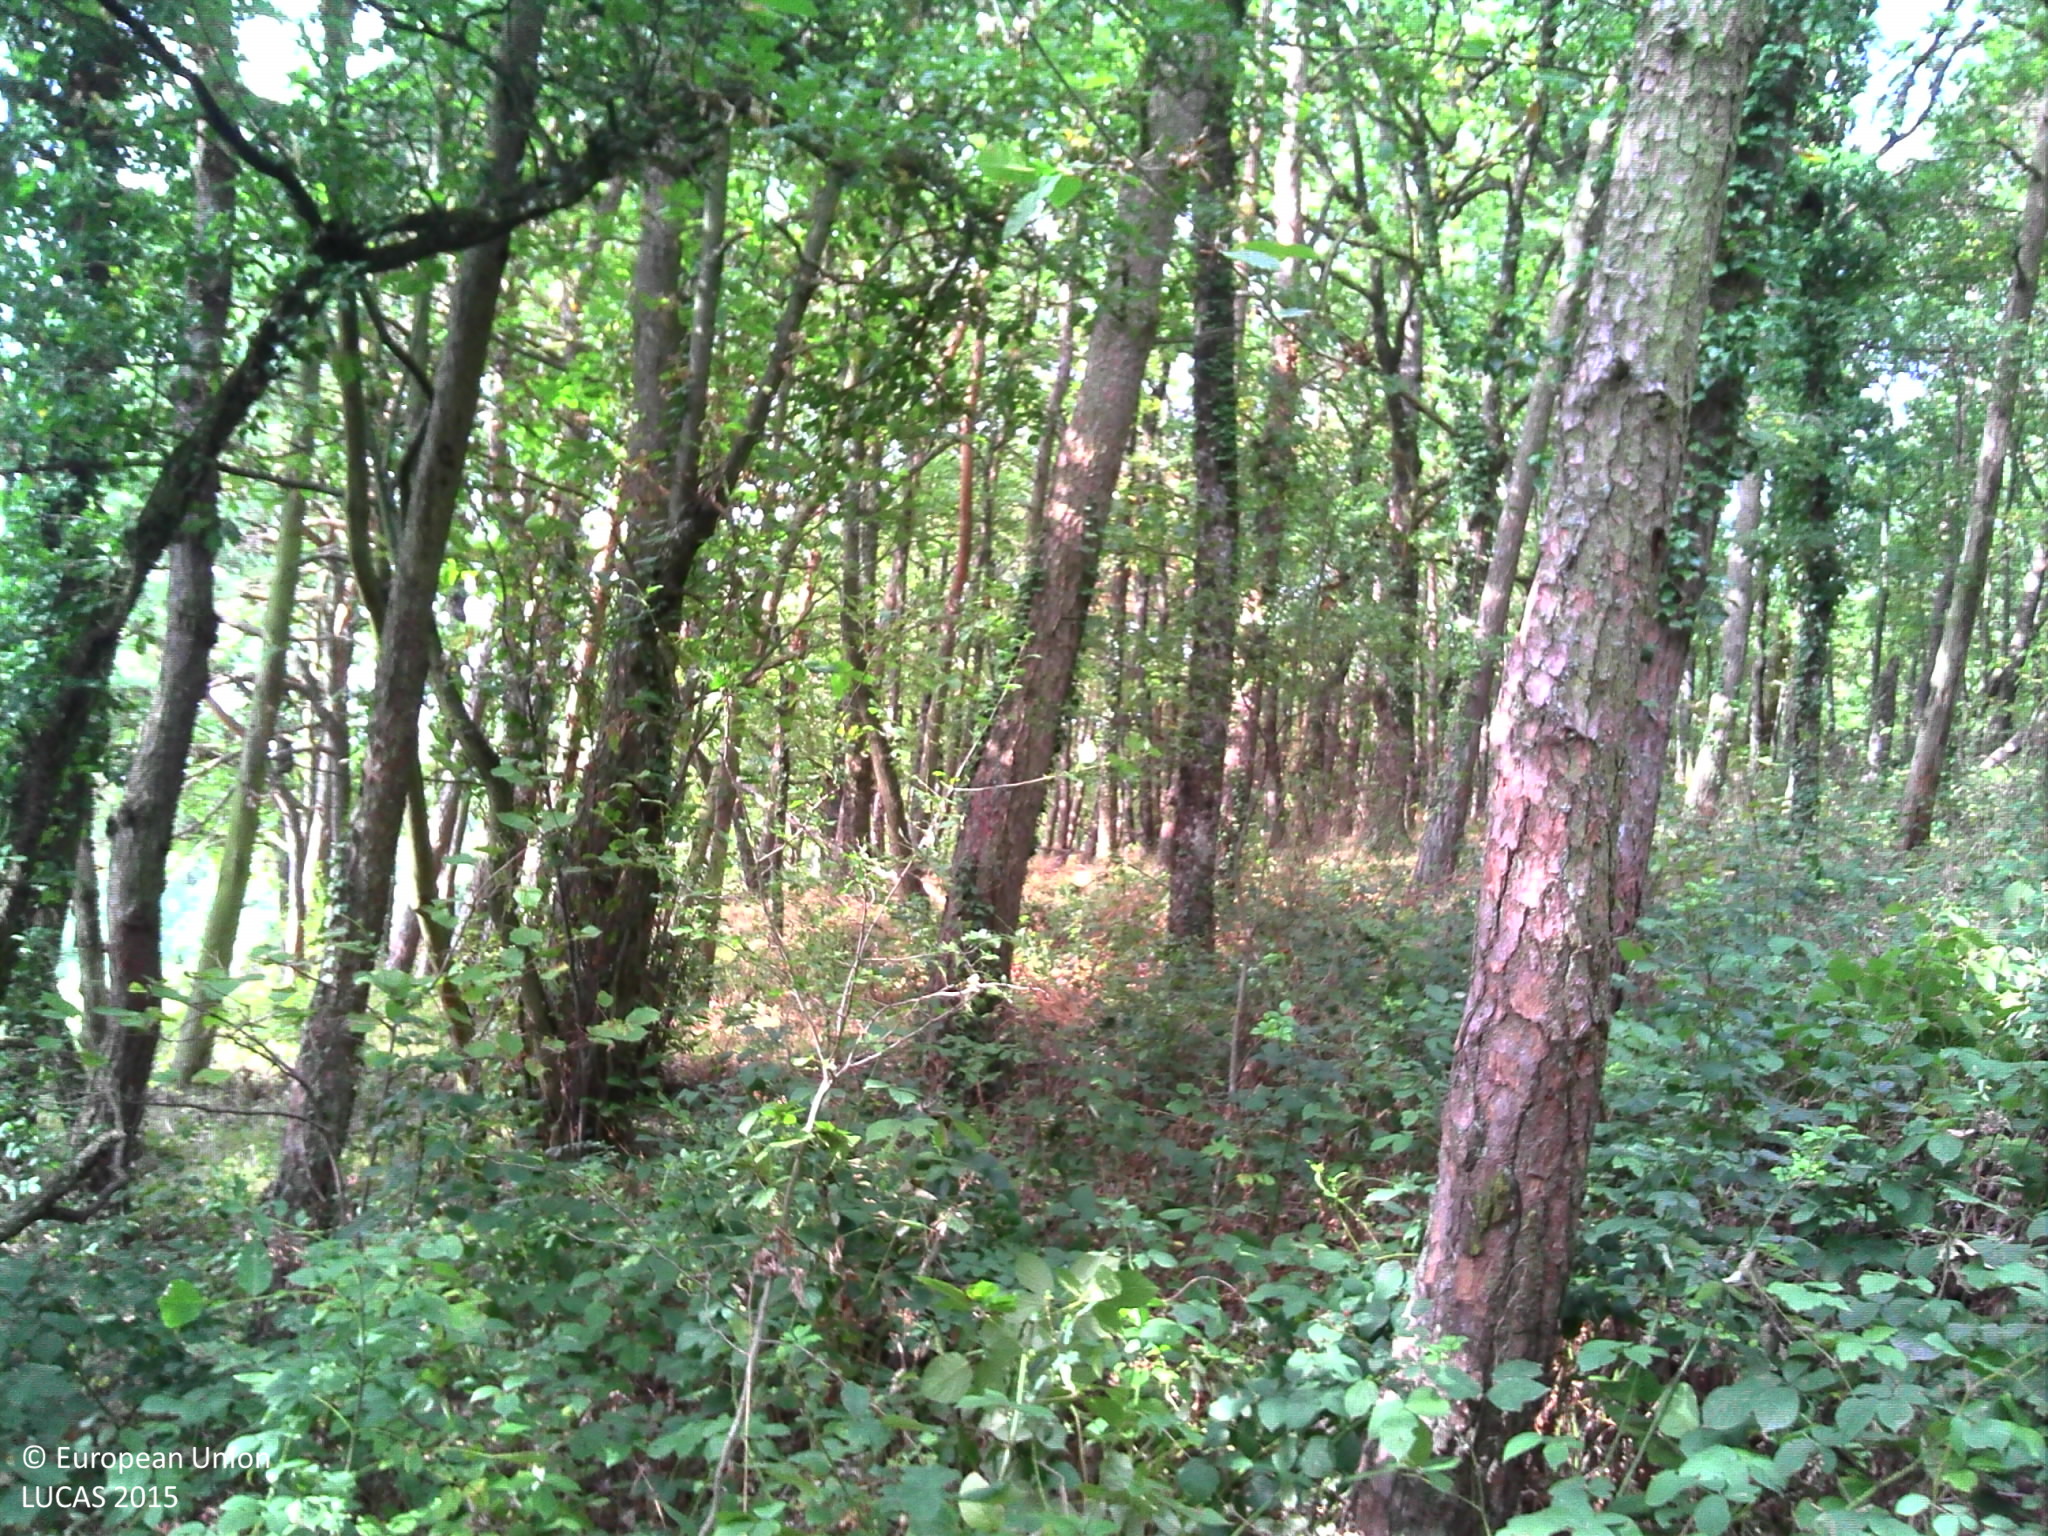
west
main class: Woodland
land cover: Broadleaved woodland
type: mesophytic deciduous forest
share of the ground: > 75 %
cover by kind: broadleaved forest trees 90 %, herbaceous plants 5 %, lichens and mosses 5 %
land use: Forestry
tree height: > 5 m
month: October
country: FR
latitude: 45.6385
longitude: 4.6282
